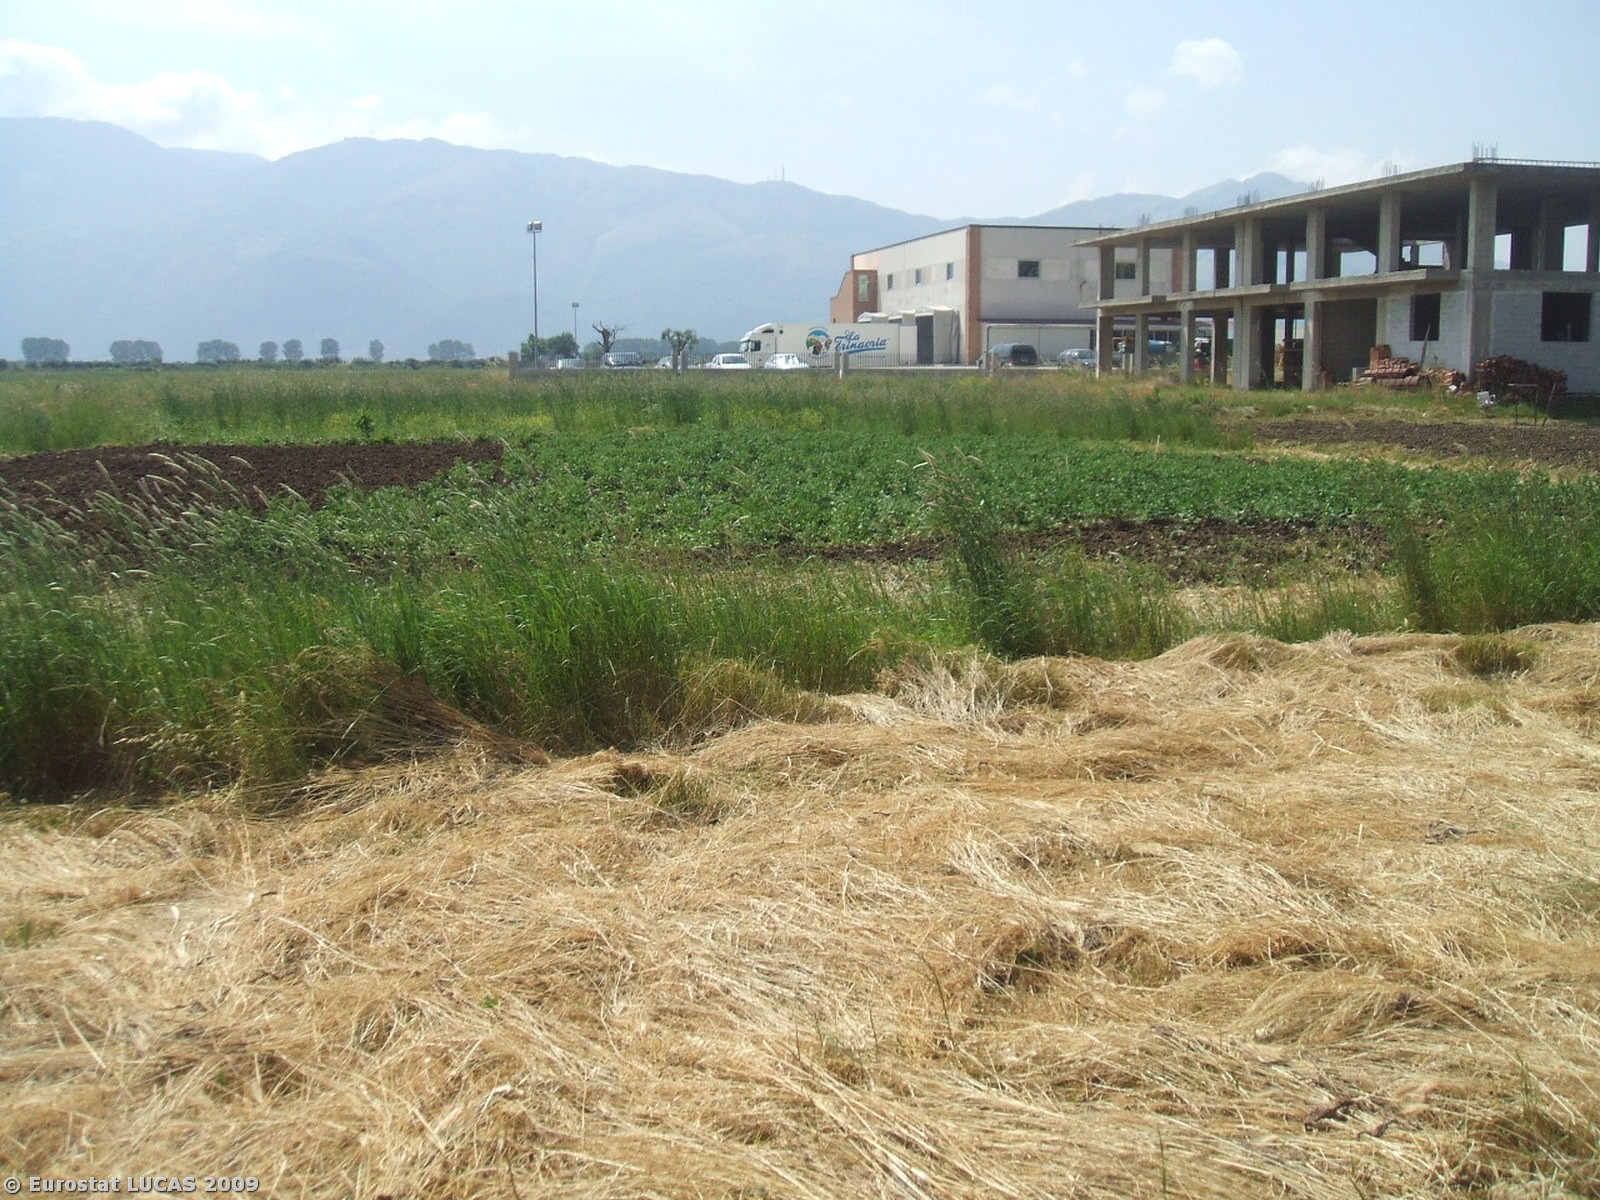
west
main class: Cropland
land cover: Other leguminous and mixtures for fodder
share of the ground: > 75 %
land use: Agriculture (excluding fallow land and kitchen gardens)
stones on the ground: < 10 %
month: May
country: IT
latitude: 40.4739
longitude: 15.5329
